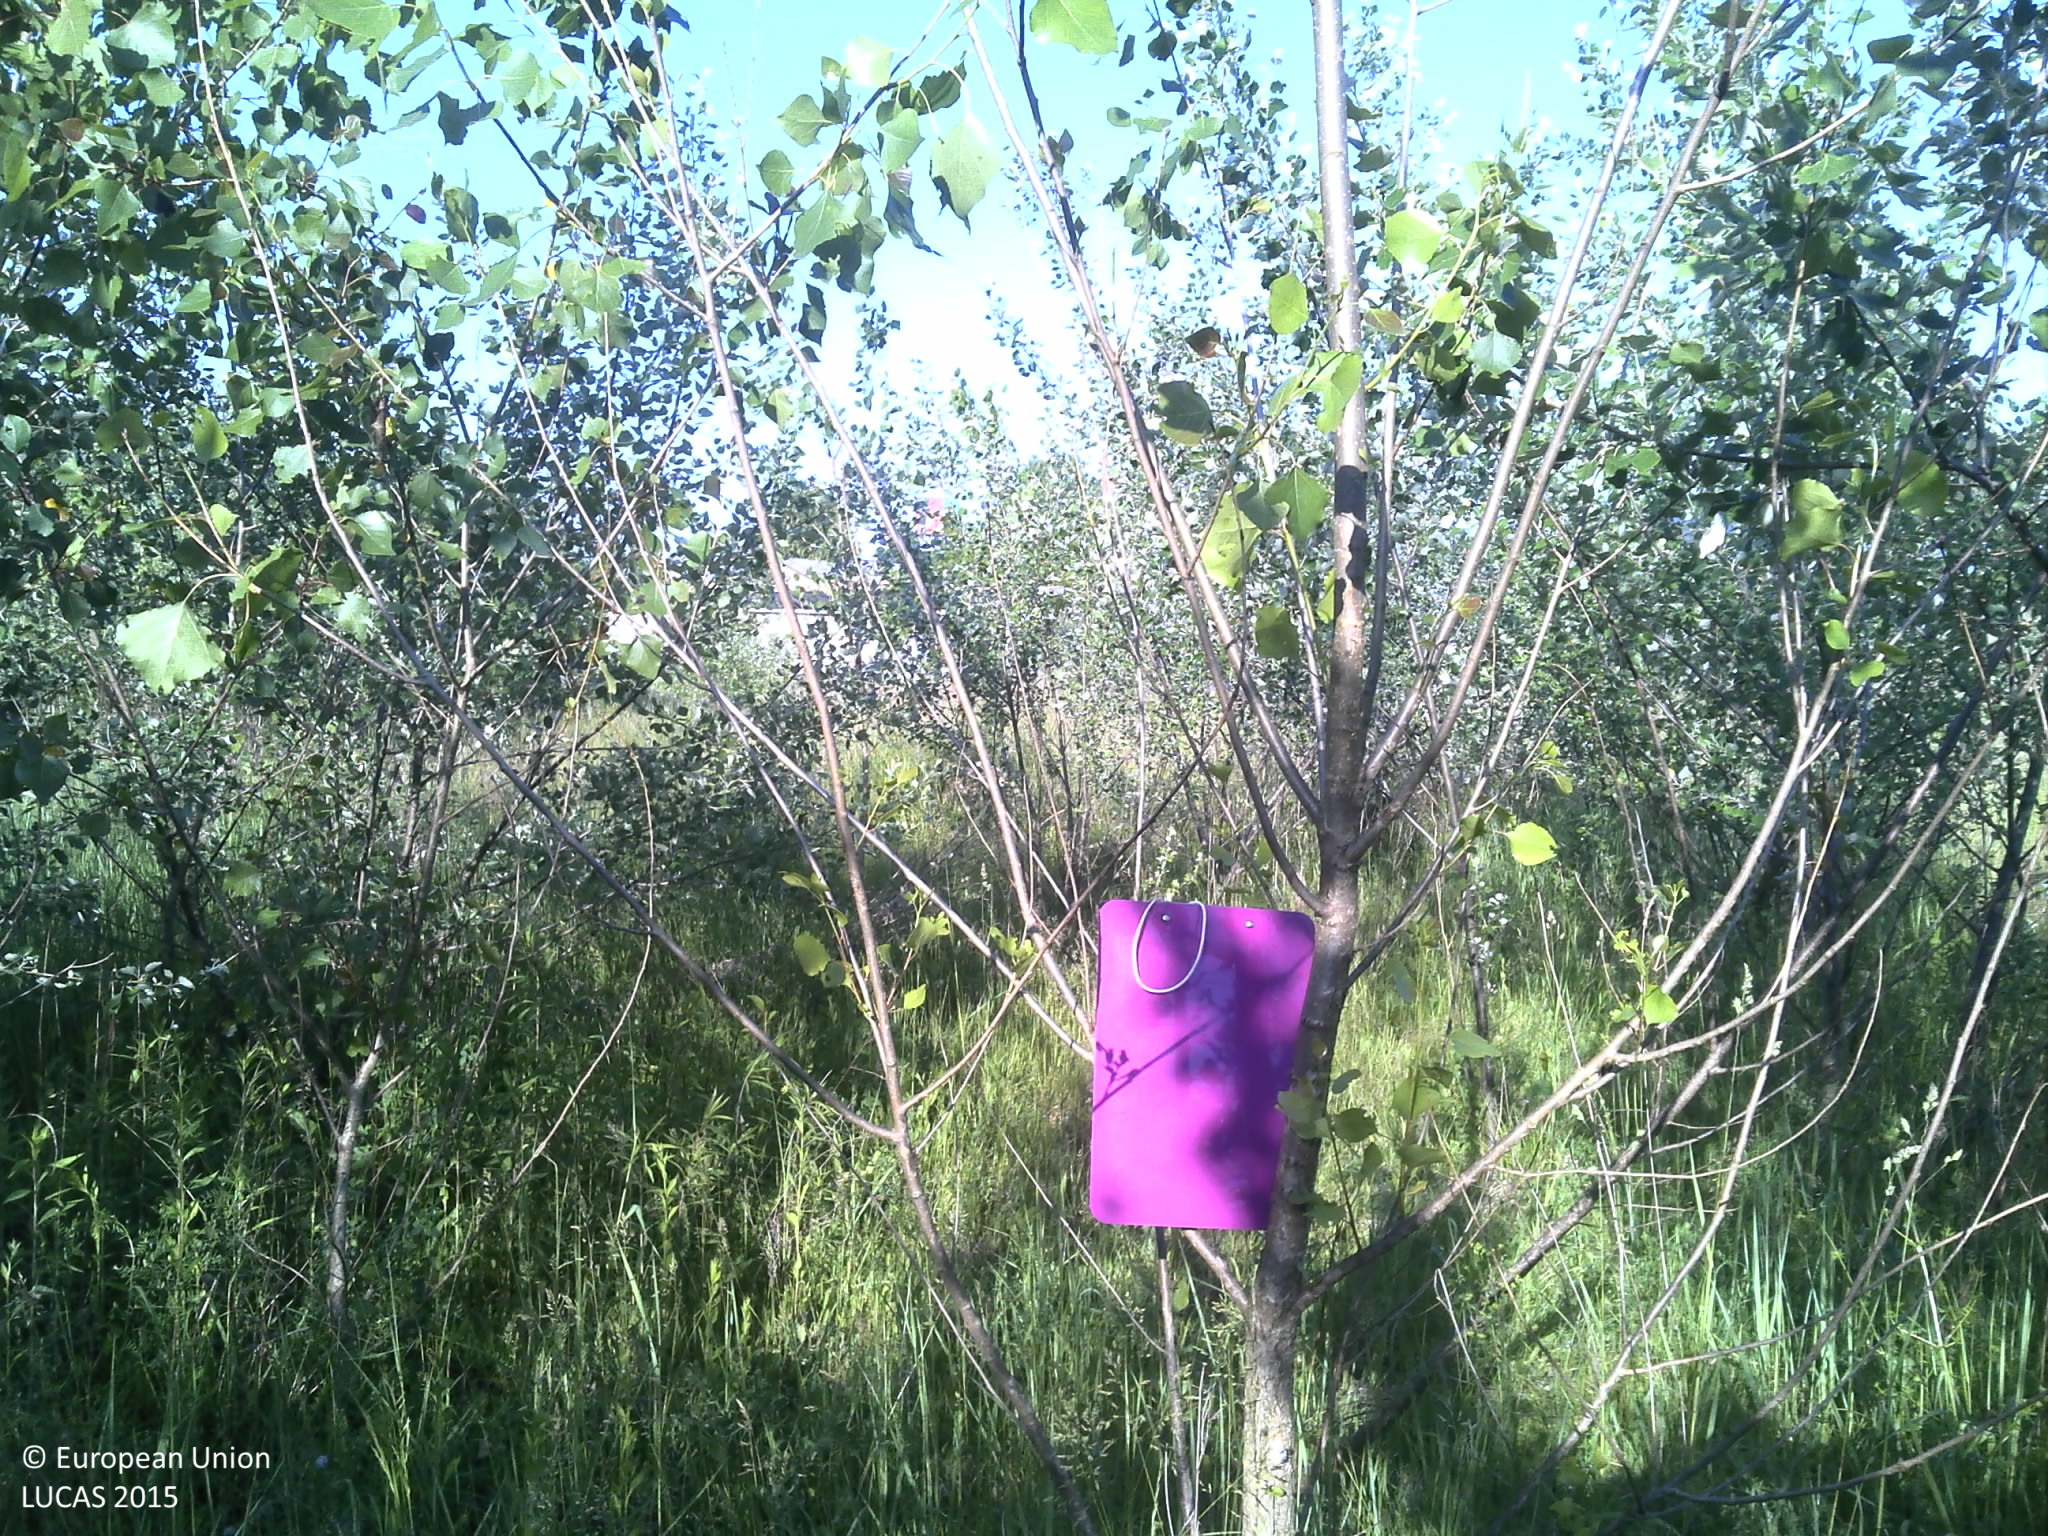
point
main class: Grassland
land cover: Grassland with sparse tree/shrub cover
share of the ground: > 75 %
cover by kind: herbaceous plants 85 %, shrubs 10 %, broadleaved forest trees 5 %
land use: Semi-natural and natural areas not in use
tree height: < 5 m
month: May
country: HR
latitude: 45.5472
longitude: 18.6531
